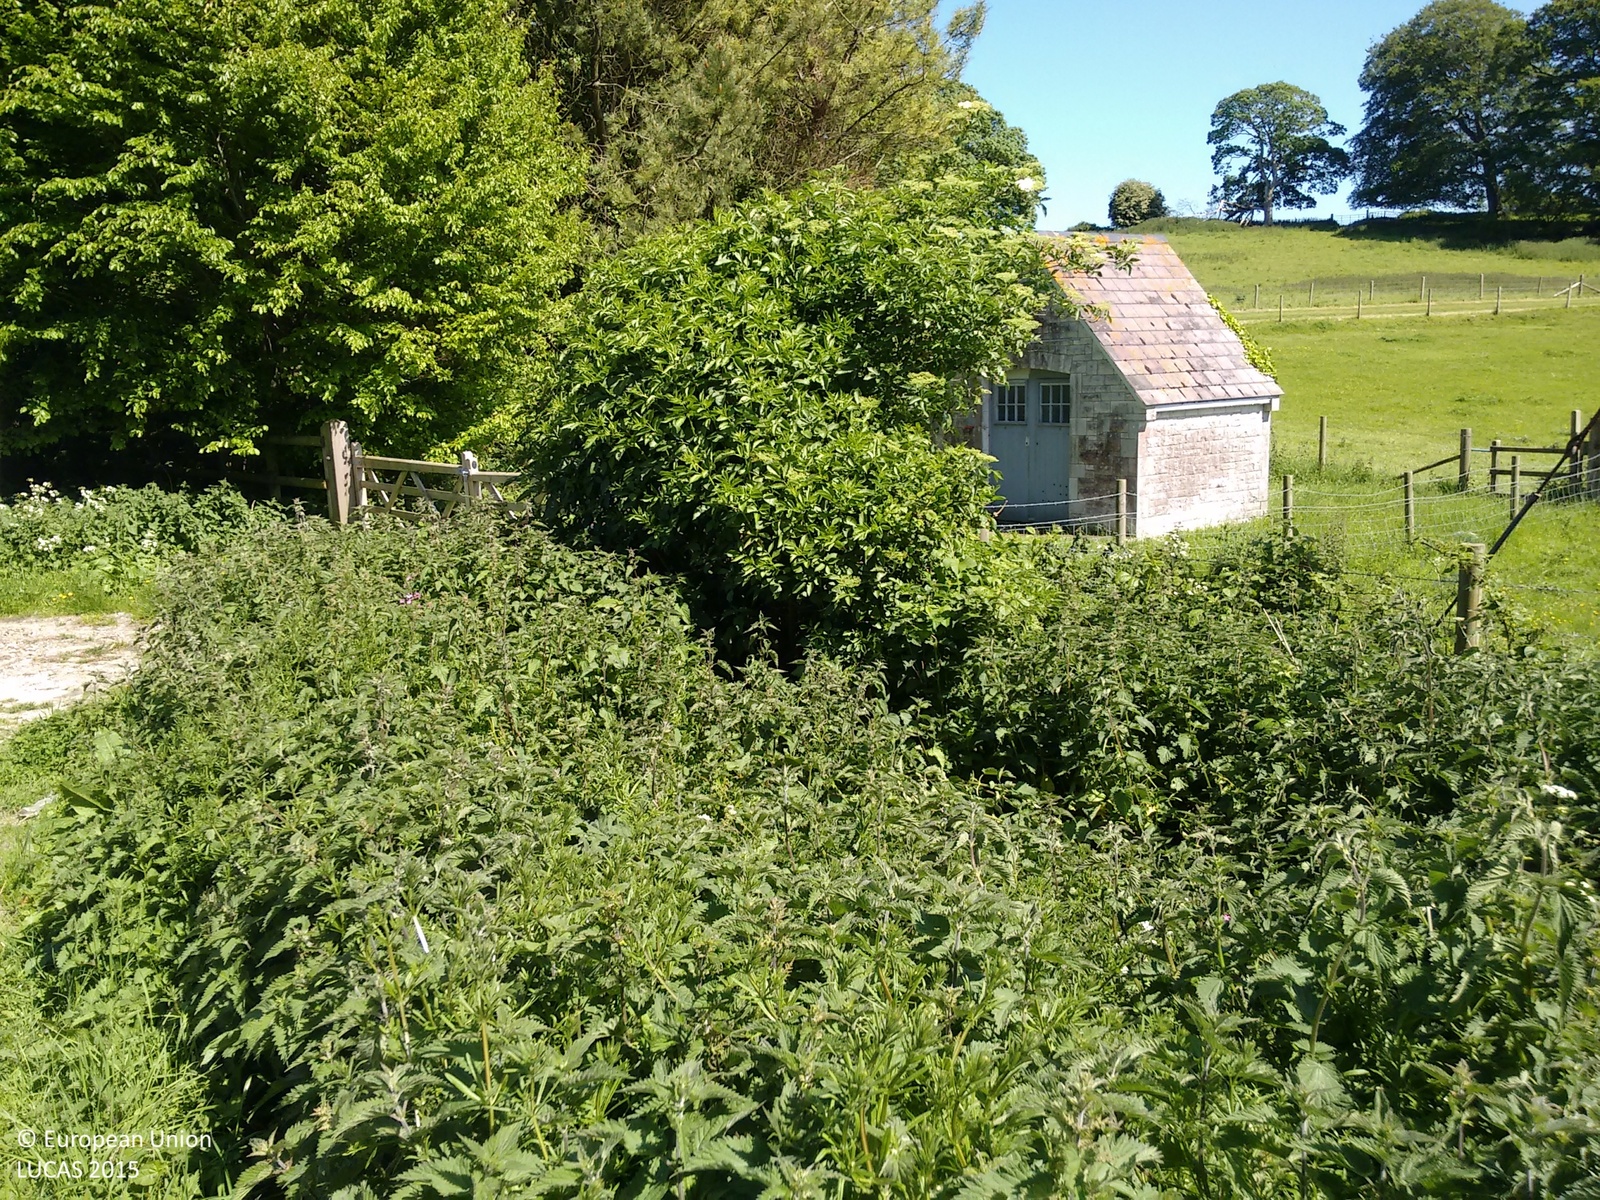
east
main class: Grassland
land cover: Spontaneously vegetated surfaces
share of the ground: > 75 %
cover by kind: herbaceous plants 95 %, shrubs 5 %
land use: Abandoned areas
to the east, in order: Spontaneously vegetated surfaces; Fences; Grassland without tree/shrub cover; Fences; Grassland without tree/shrub cover; Spontaneously vegetated surfaces; Fences; Broadleaved woodland; Fences; Tracks; Fences; Grassland without tree/shrub cover; Grassland with sparse tree/shrub cover; Grassland without tree/shrub cover; Managed hedges; Fences; Managed hedges; Grassland without tree/shrub cover
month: June
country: GB
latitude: 50.7231
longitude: -2.4025
